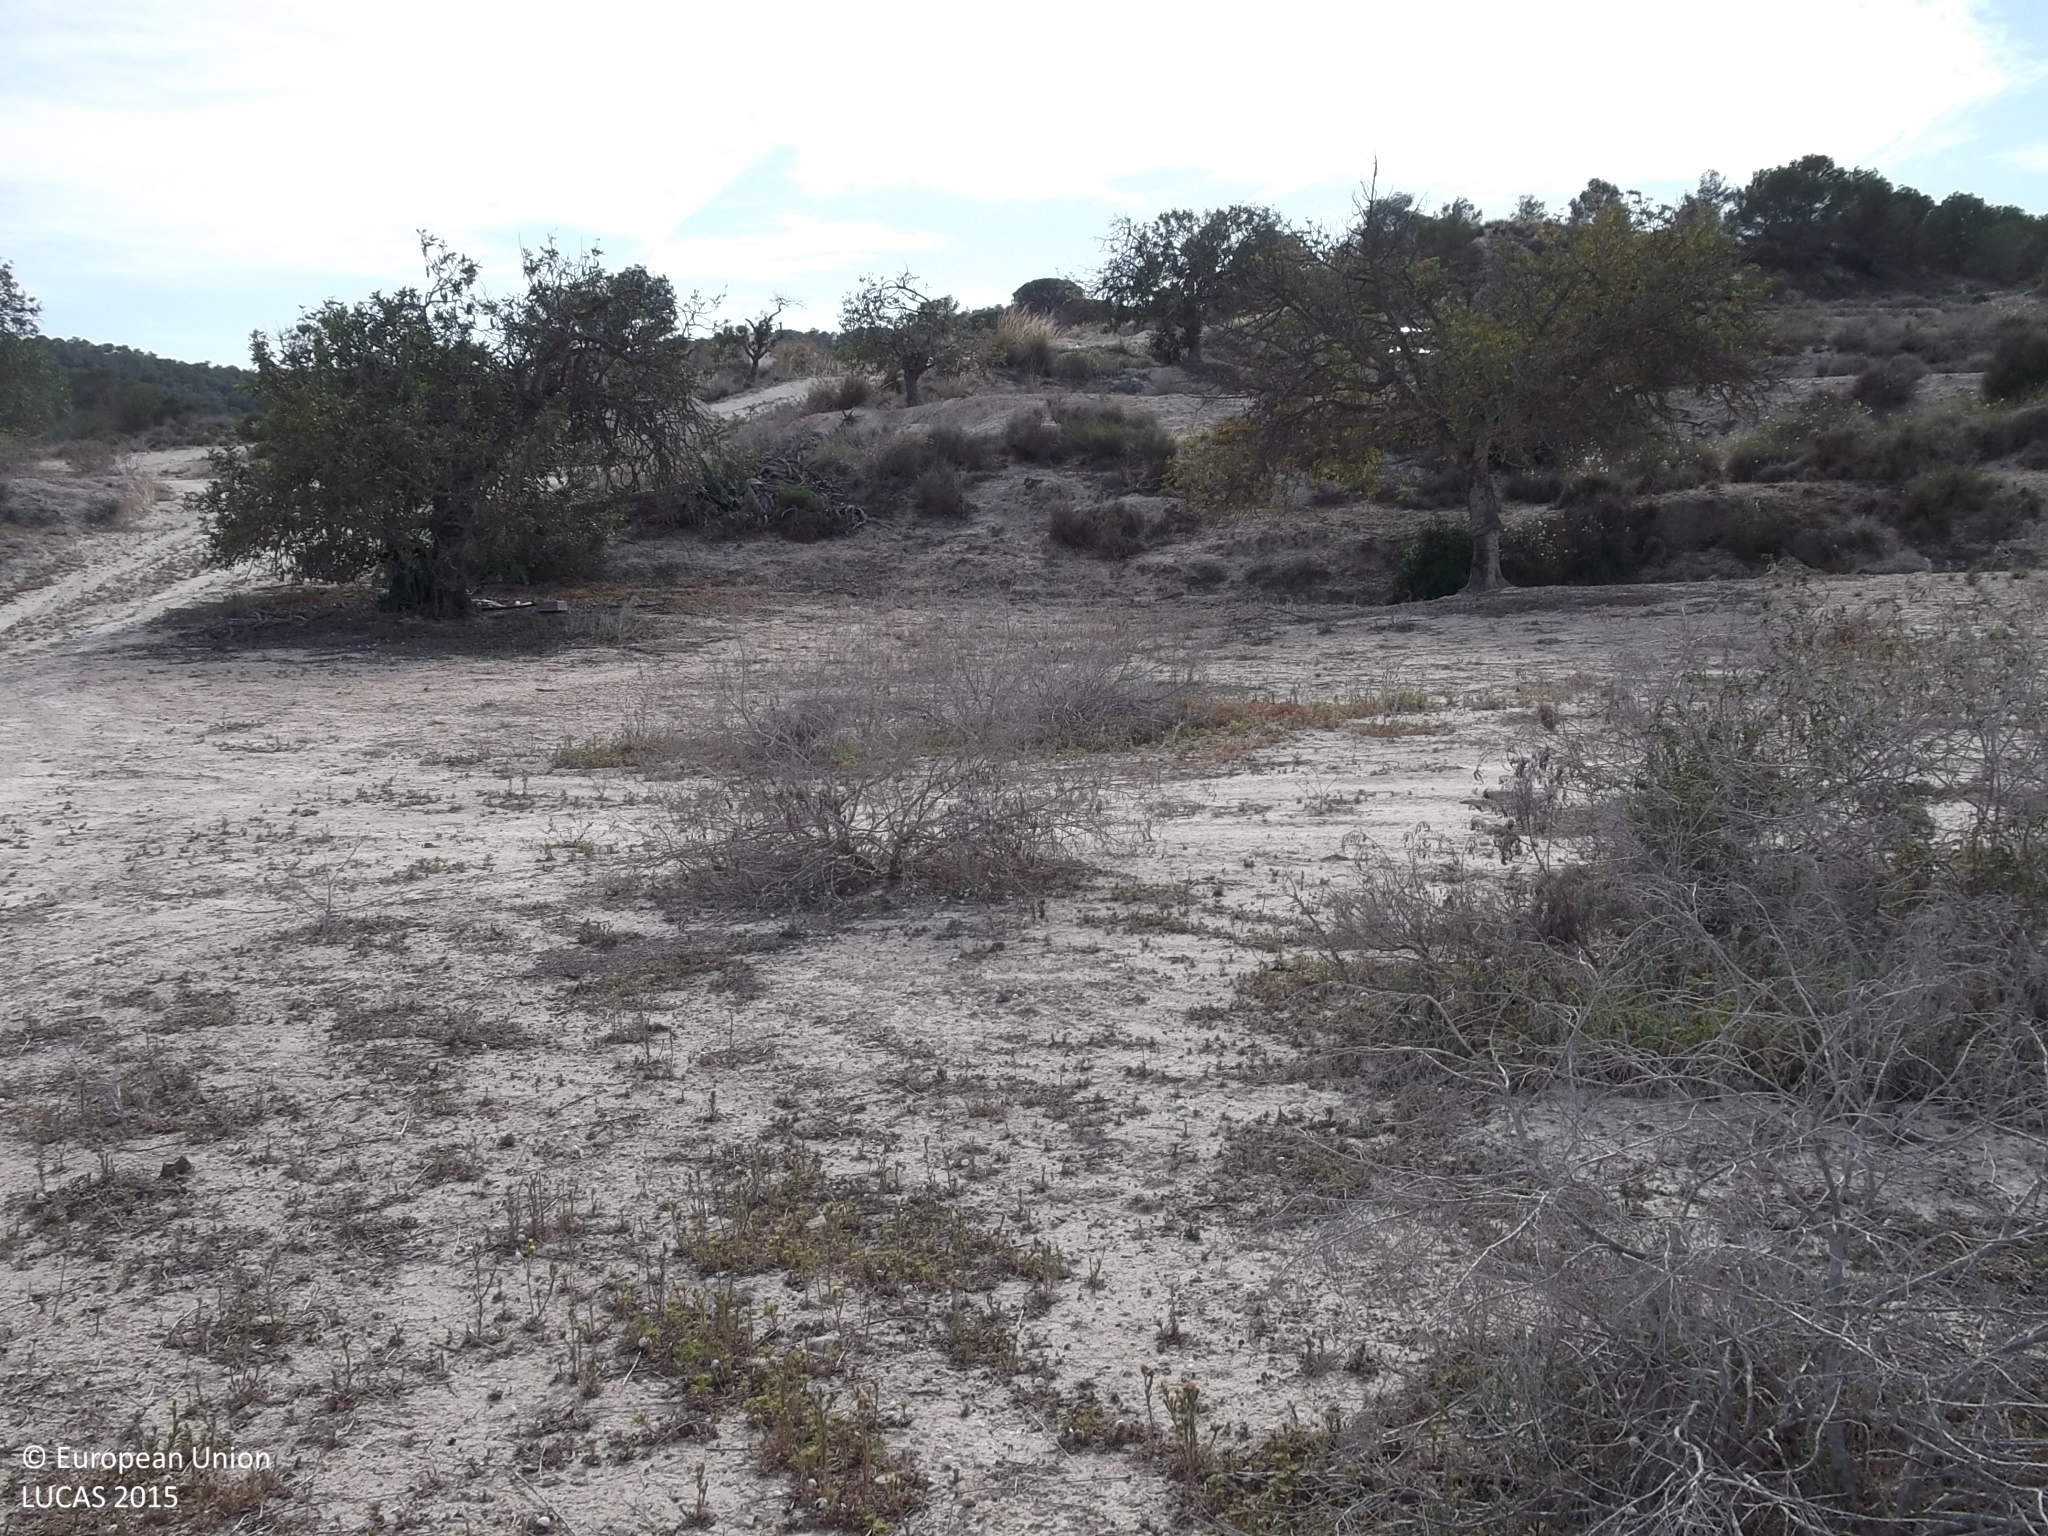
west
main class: Shrubland
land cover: Shrubland without tree cover
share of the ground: 10 - 25 %
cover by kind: consolidated bare surface 50 %, herbaceous plants 30 %, shrubs 20 %
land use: Semi-natural and natural areas not in use
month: May
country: ES
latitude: 37.9705
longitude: -0.8079
